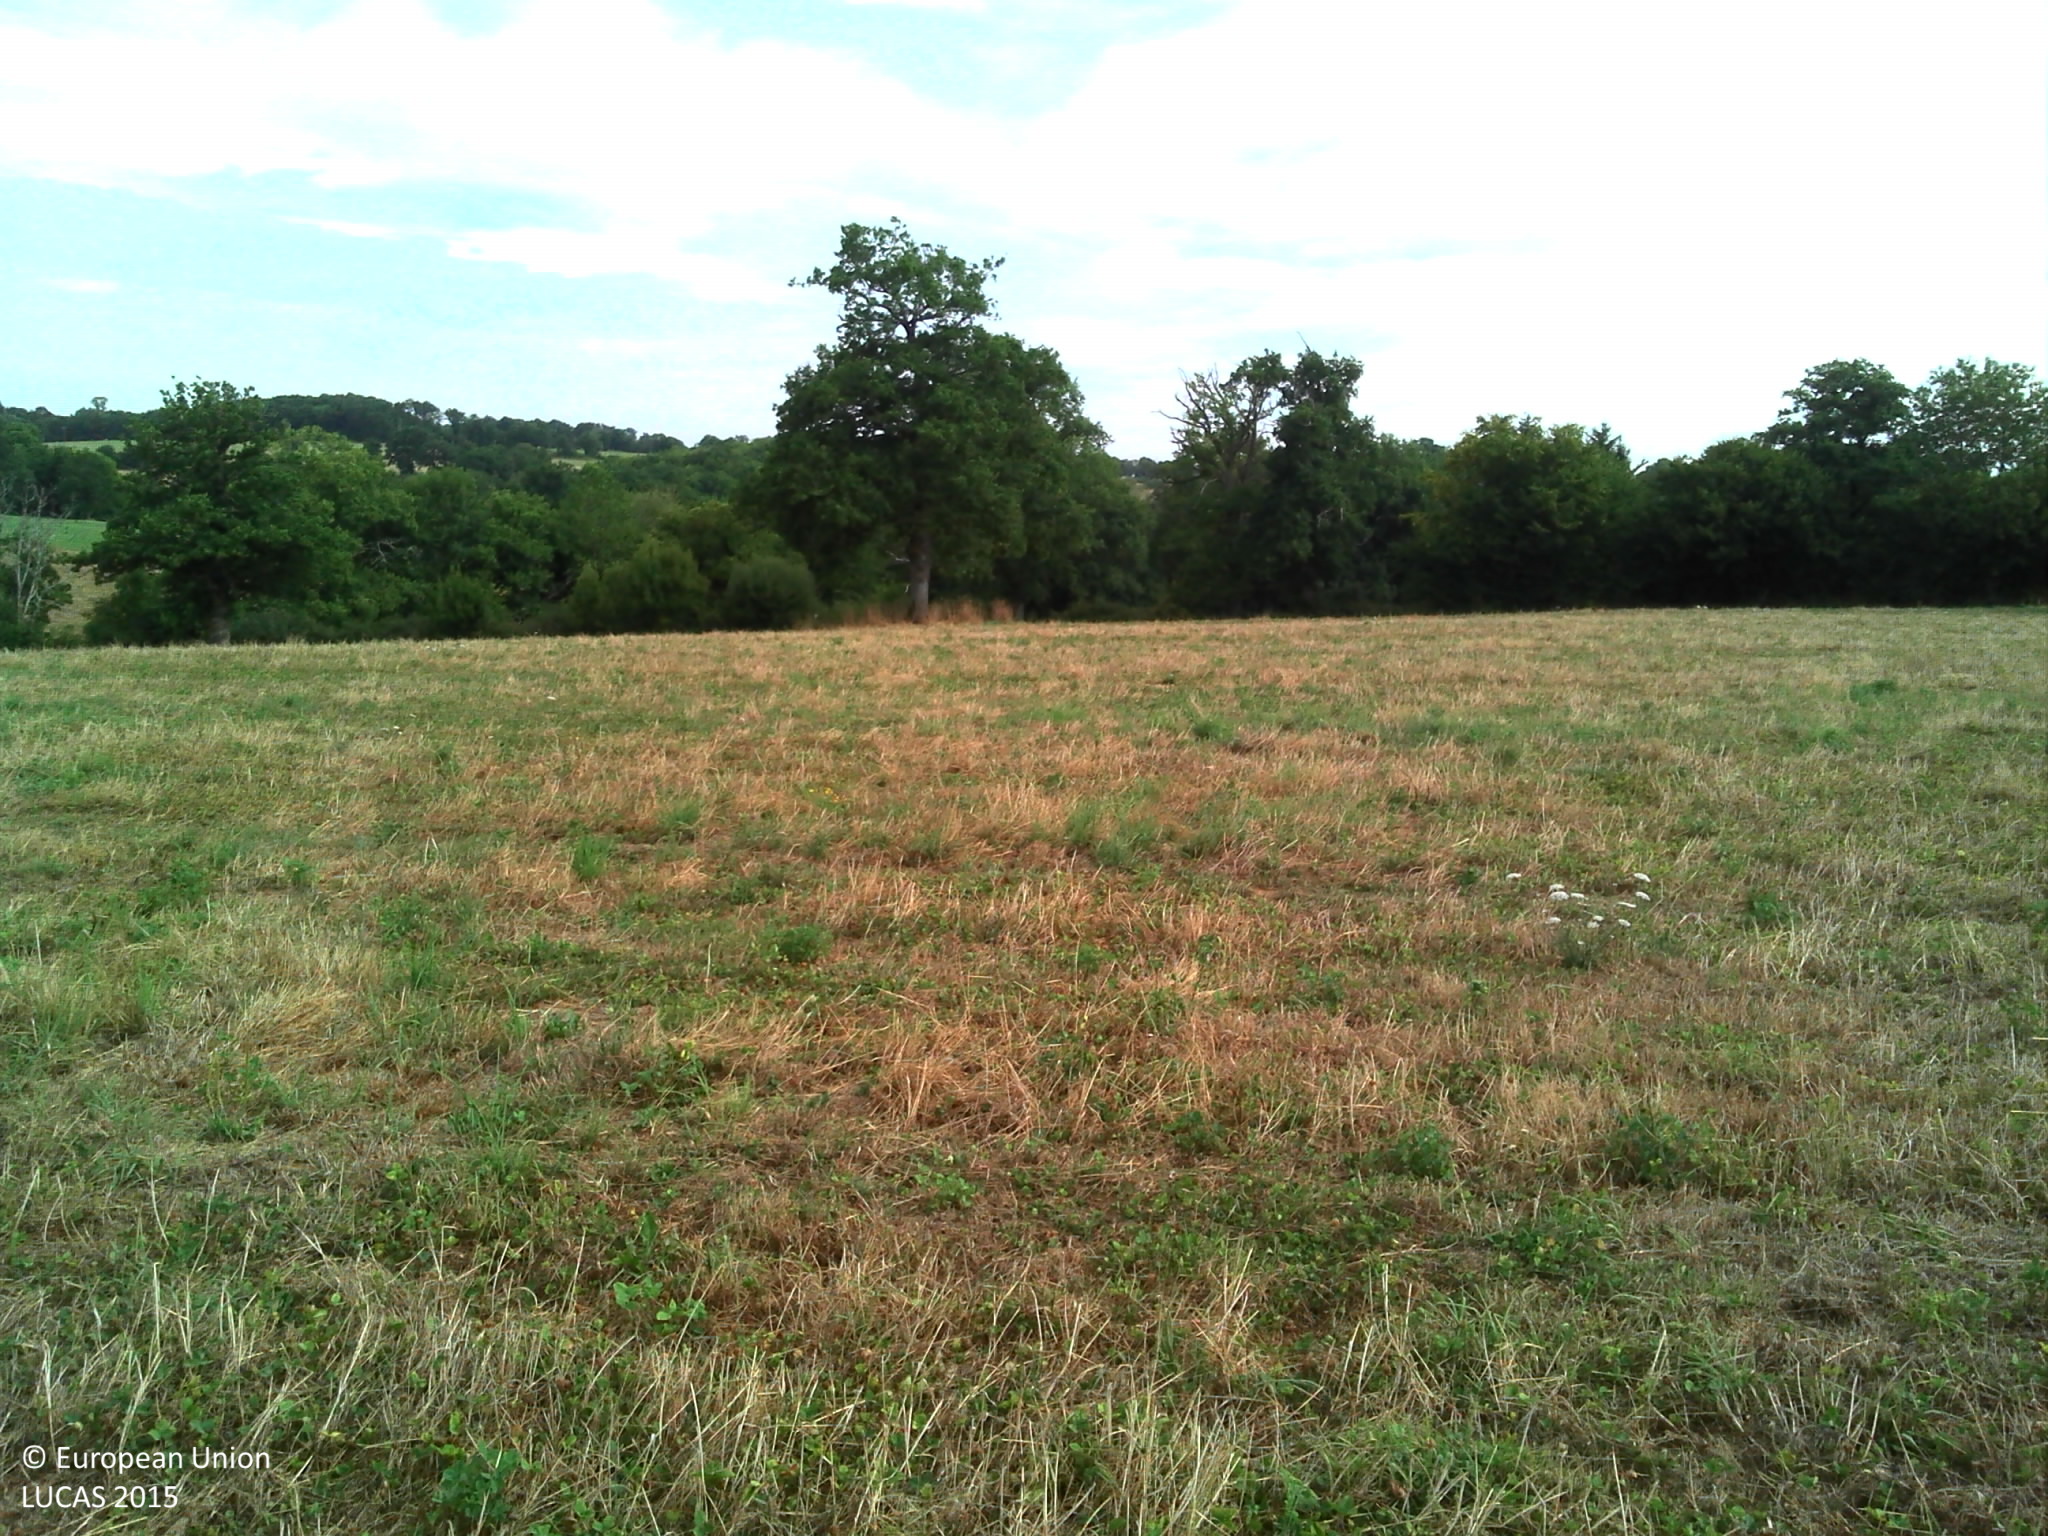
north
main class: Grassland
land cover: Grassland without tree/shrub cover
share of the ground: > 75 %
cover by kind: herbaceous plants 100 %
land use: Agriculture (excluding fallow land and kitchen gardens)
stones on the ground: > 50 %
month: July
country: FR
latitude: 46.2542
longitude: 0.9194
